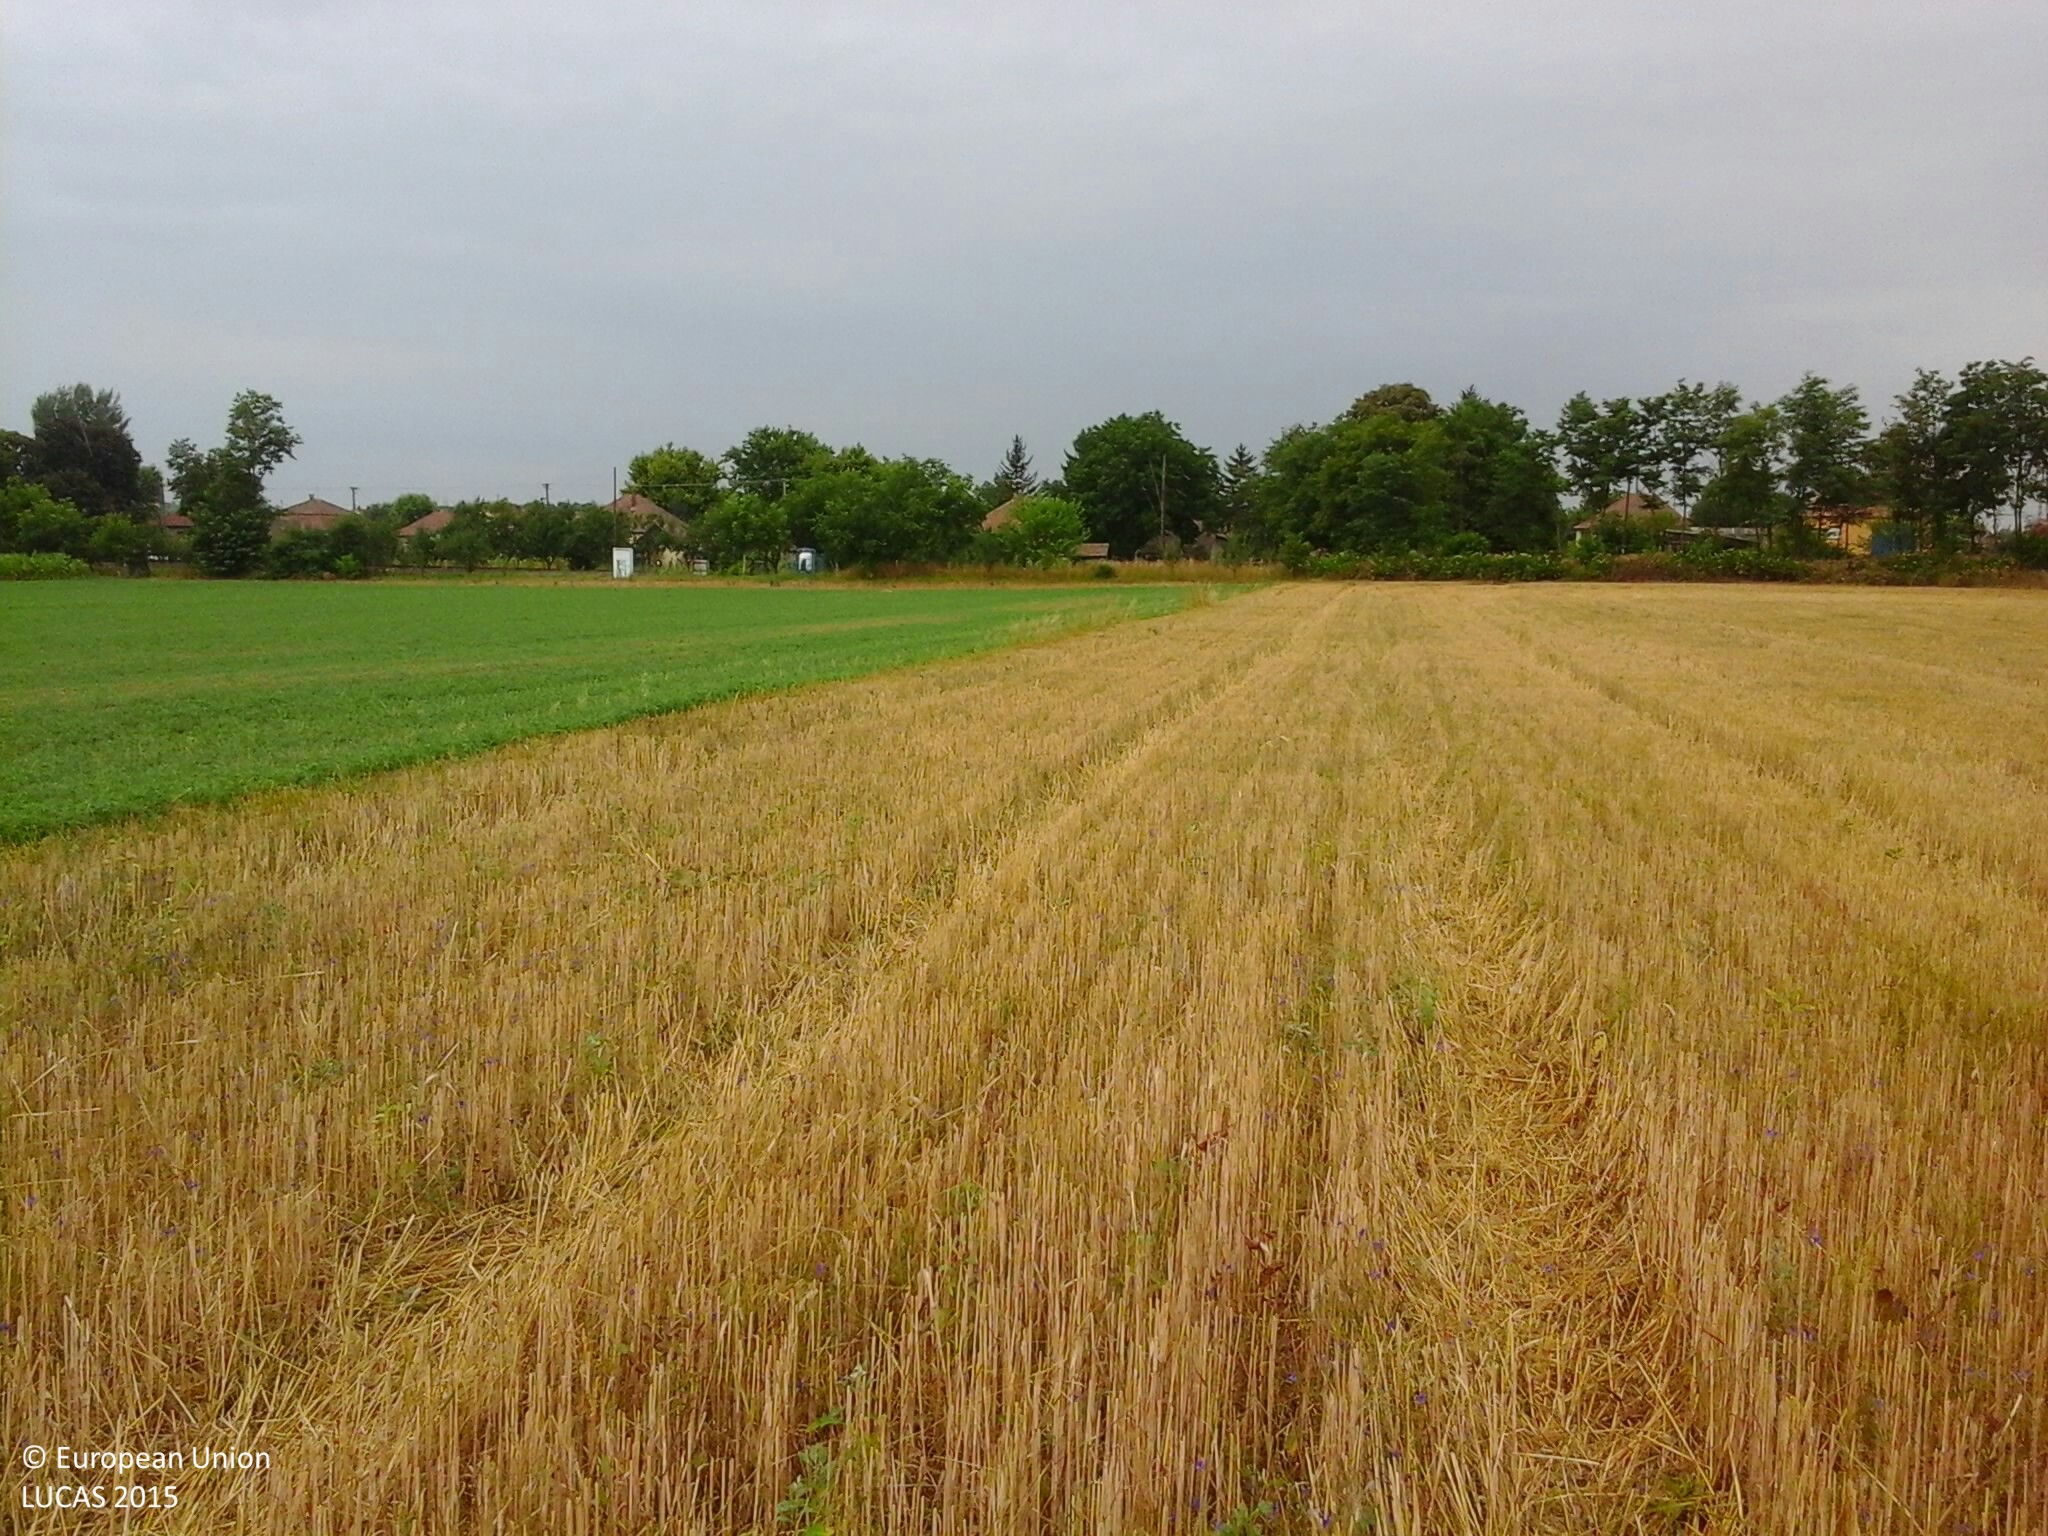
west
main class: Cropland
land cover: Barley
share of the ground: 25 - 50 %
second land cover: Spontaneously vegetated surfaces
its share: < 10 %
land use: Agriculture (excluding fallow land and kitchen gardens)
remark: Harvested field
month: July
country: HU
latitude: 47.9696
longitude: 19.3581
